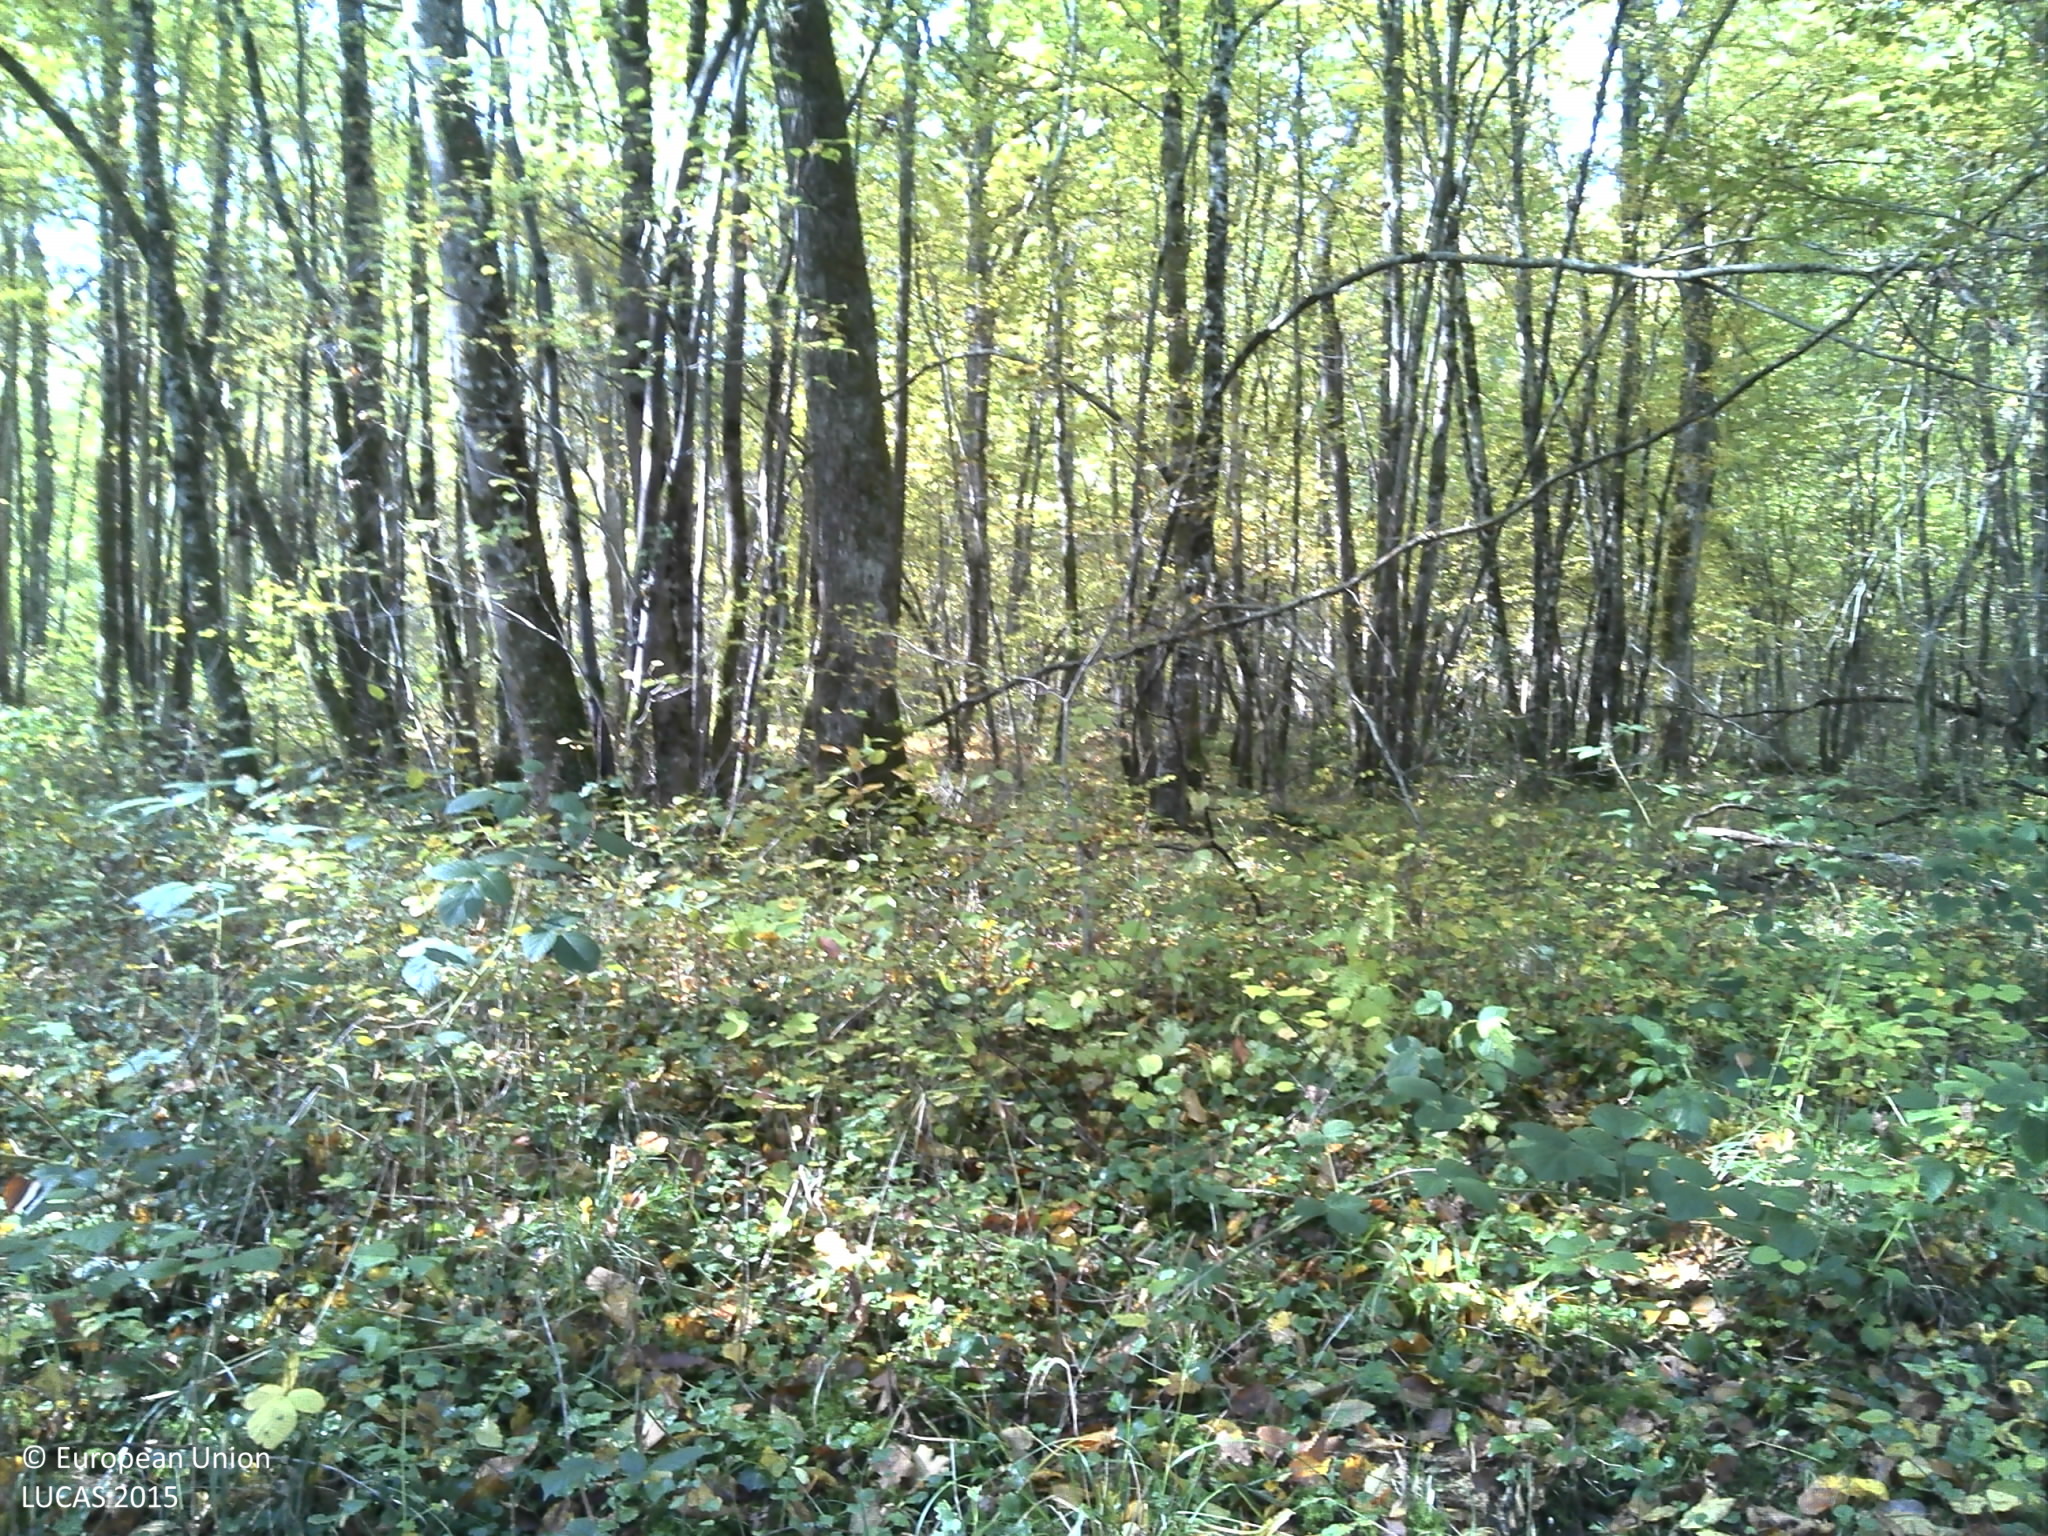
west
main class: Woodland
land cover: Broadleaved woodland
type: mesophytic deciduous forest
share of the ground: > 75 %
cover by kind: broadleaved forest trees 90 %, lichens and mosses 5 %, unconsolidated bare surface 5 %
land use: Forestry
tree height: > 5 m
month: October
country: FR
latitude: 45.8916
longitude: 5.4030
